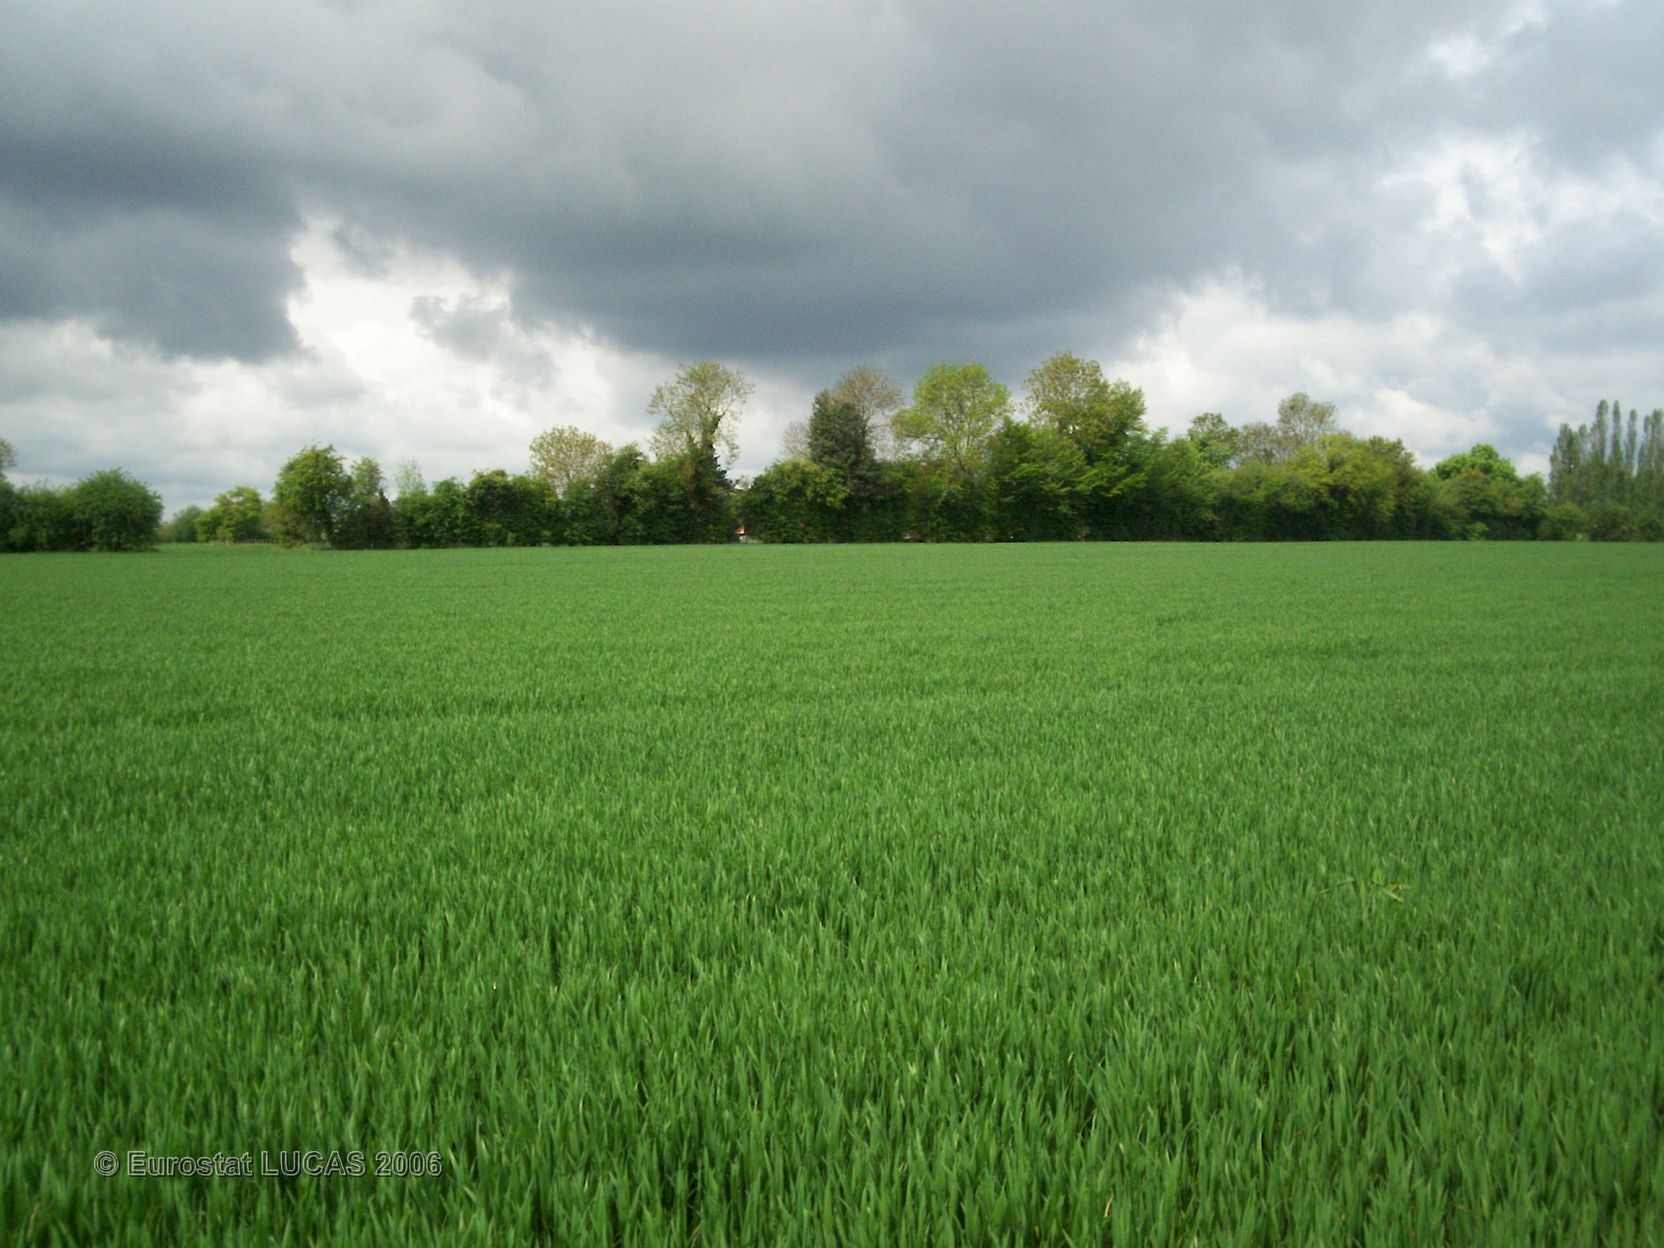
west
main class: Cropland
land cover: Common wheat
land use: Agriculture (excluding fallow land and kitchen gardens)
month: May
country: FR
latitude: 49.0638
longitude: 0.5168
